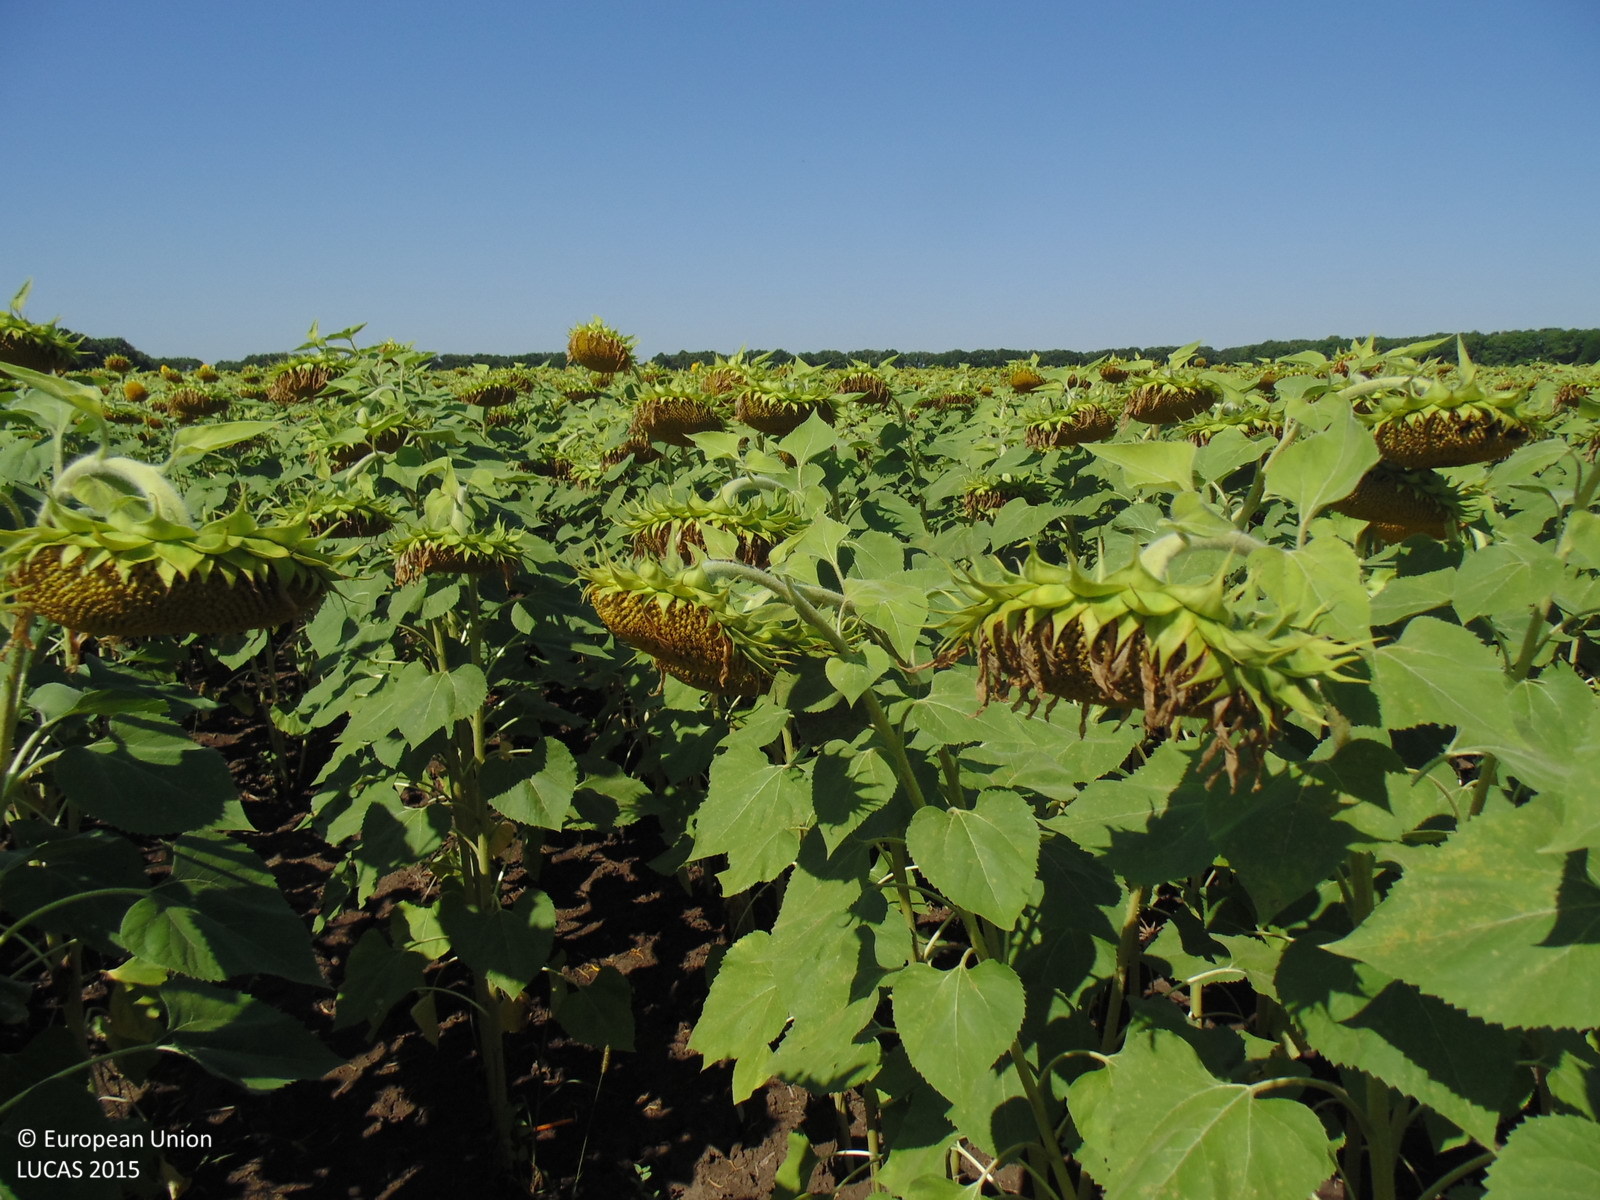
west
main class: Cropland
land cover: Sunflower
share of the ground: > 75 %
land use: Agriculture (excluding fallow land and kitchen gardens)
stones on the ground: < 10 %
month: August
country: BG
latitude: 43.5524
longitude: 28.1103
